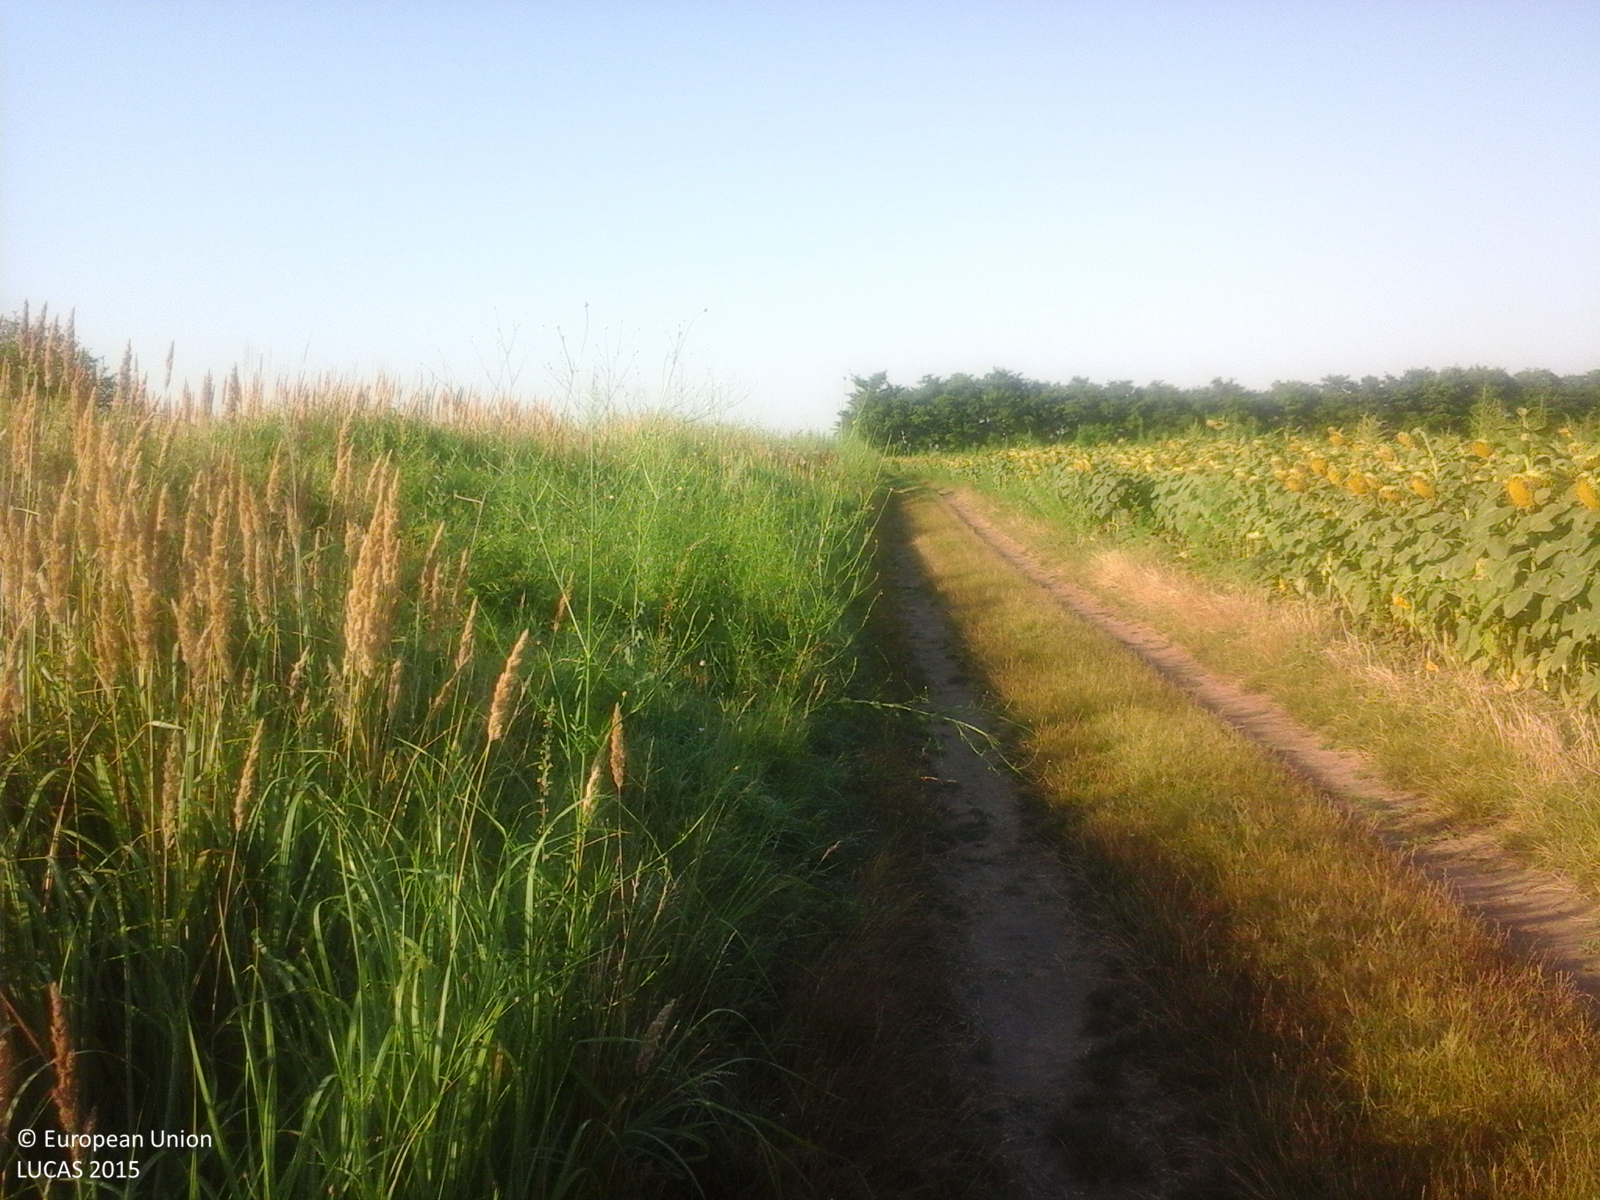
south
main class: Cropland
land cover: Sunflower
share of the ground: > 75 %
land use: Agriculture (excluding fallow land and kitchen gardens)
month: July
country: RO
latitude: 44.4982
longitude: 27.2267
